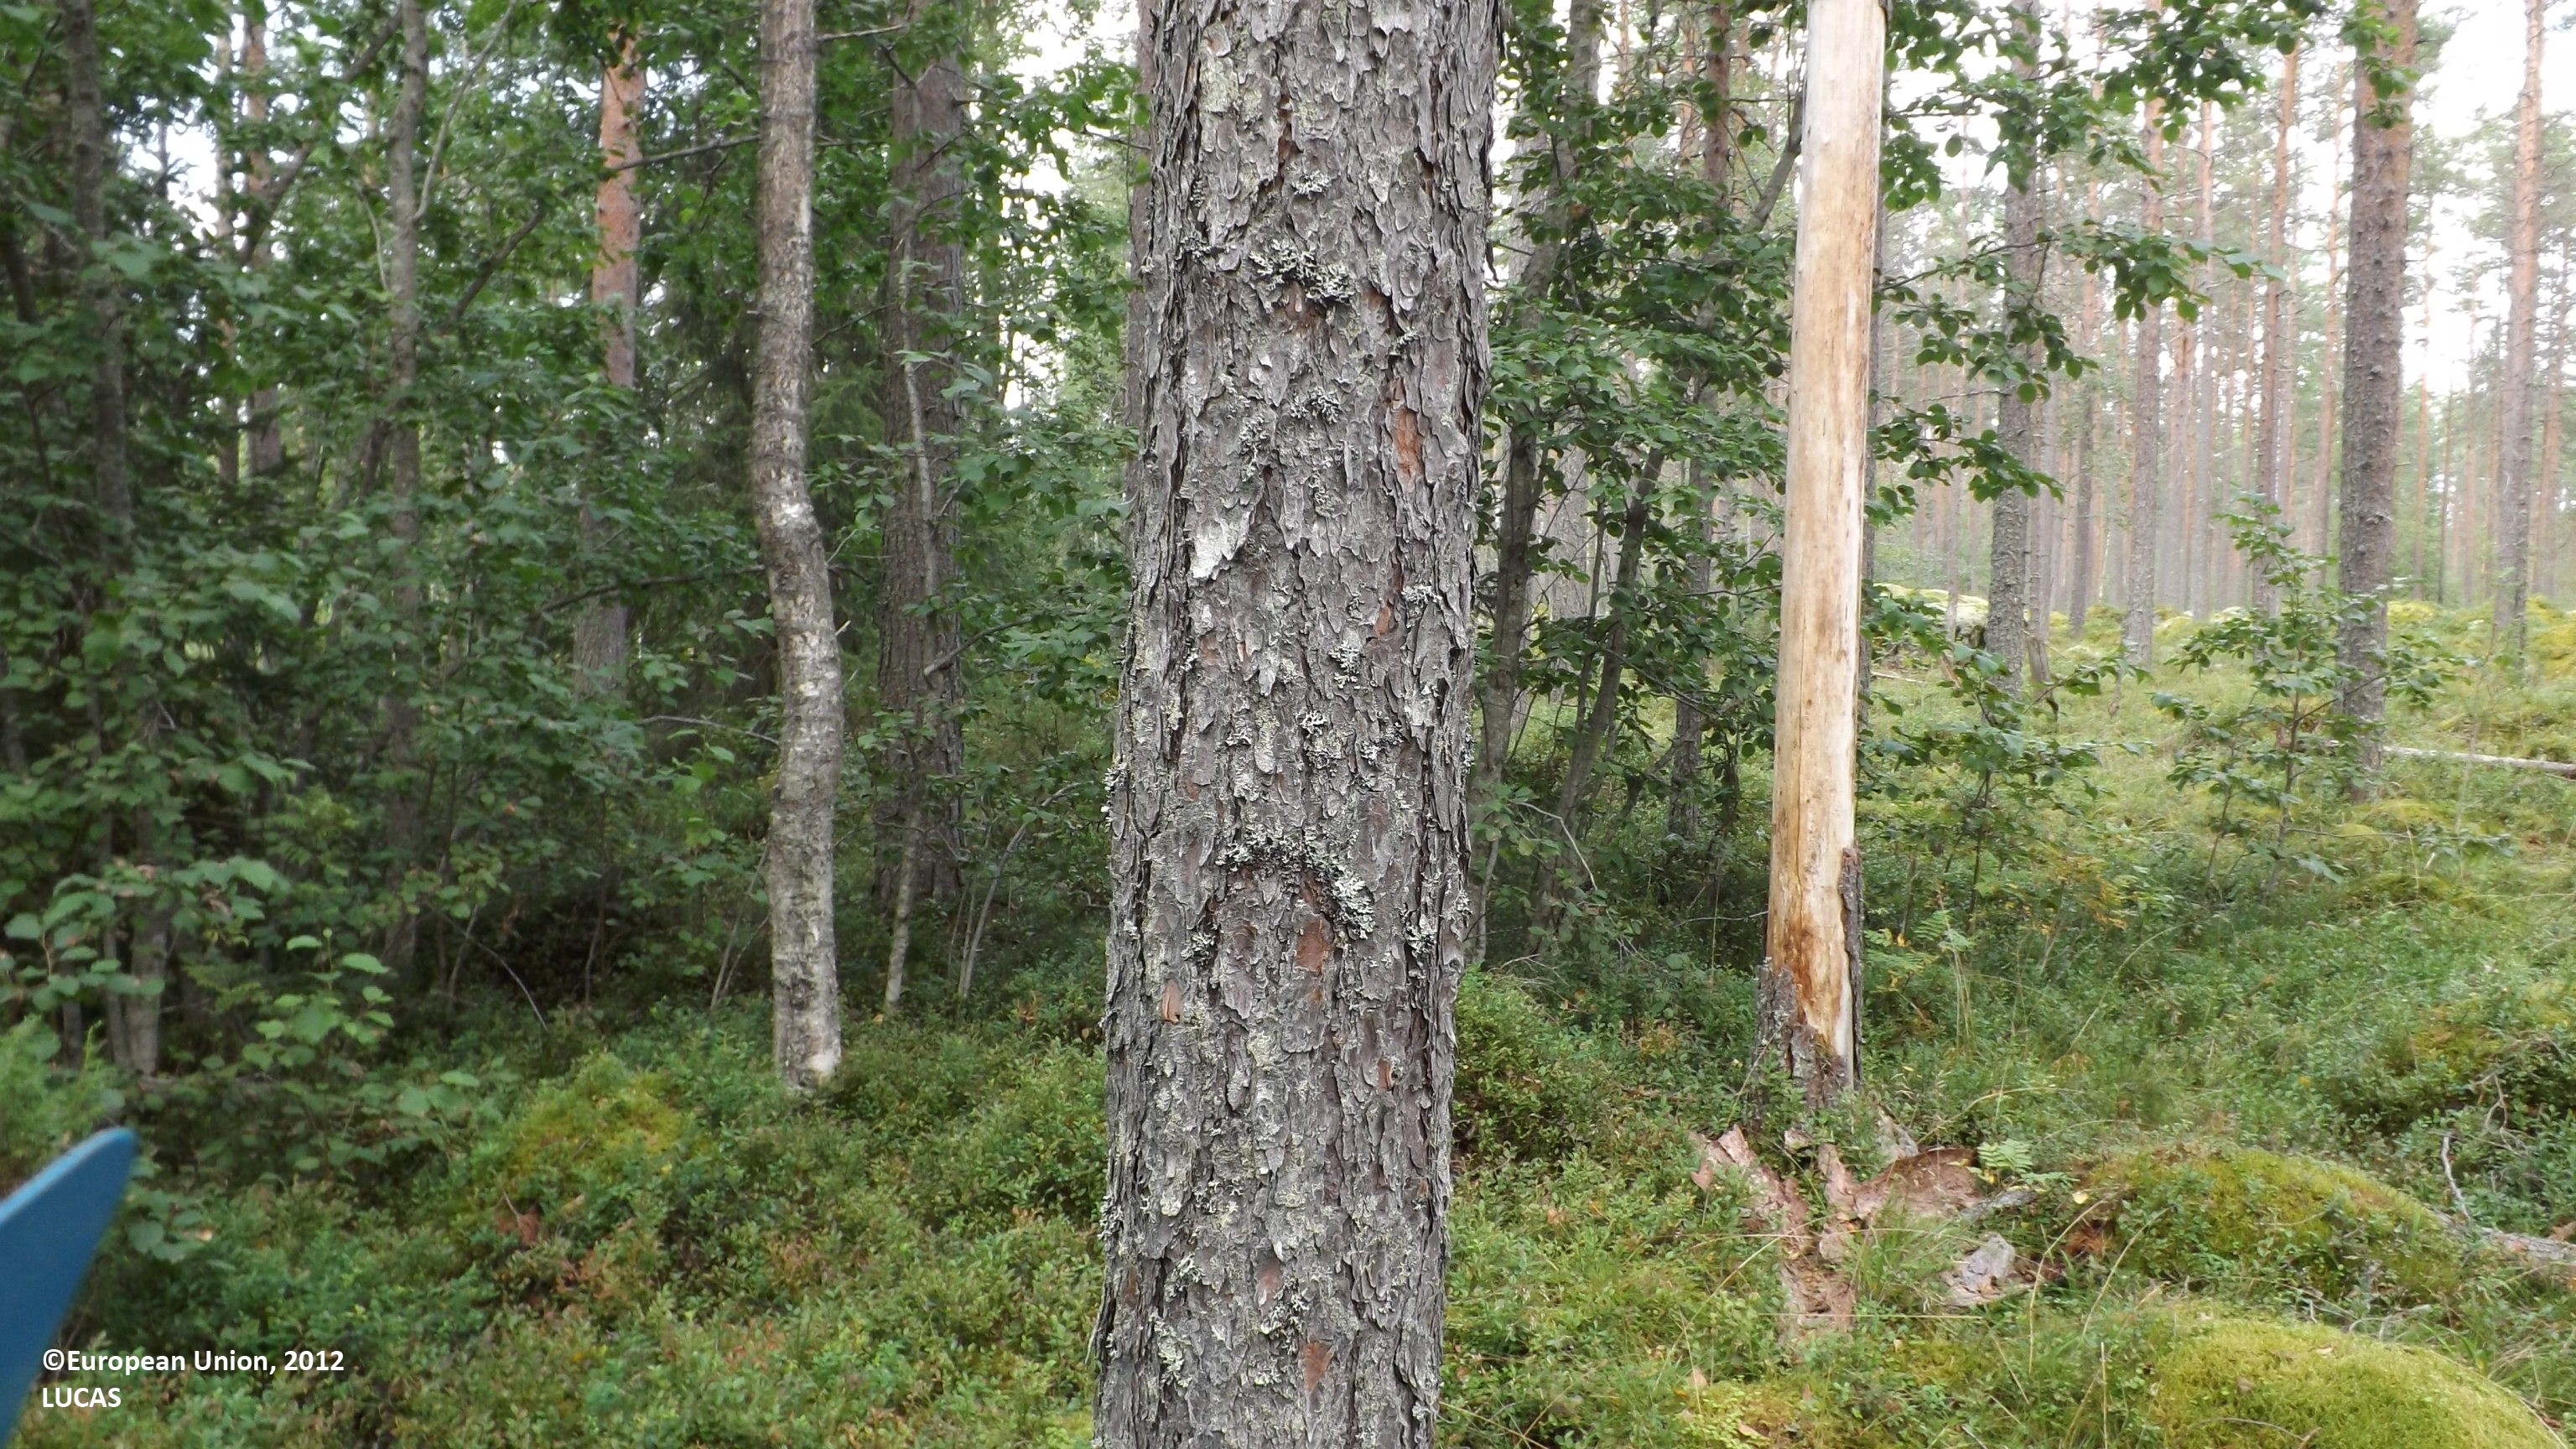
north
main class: Woodland
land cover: Pine dominated mixed woodland
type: boreal forest
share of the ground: 25 - 50 %
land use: Forestry
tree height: > 5 m
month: August
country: FI
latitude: 63.7170
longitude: 24.0150
